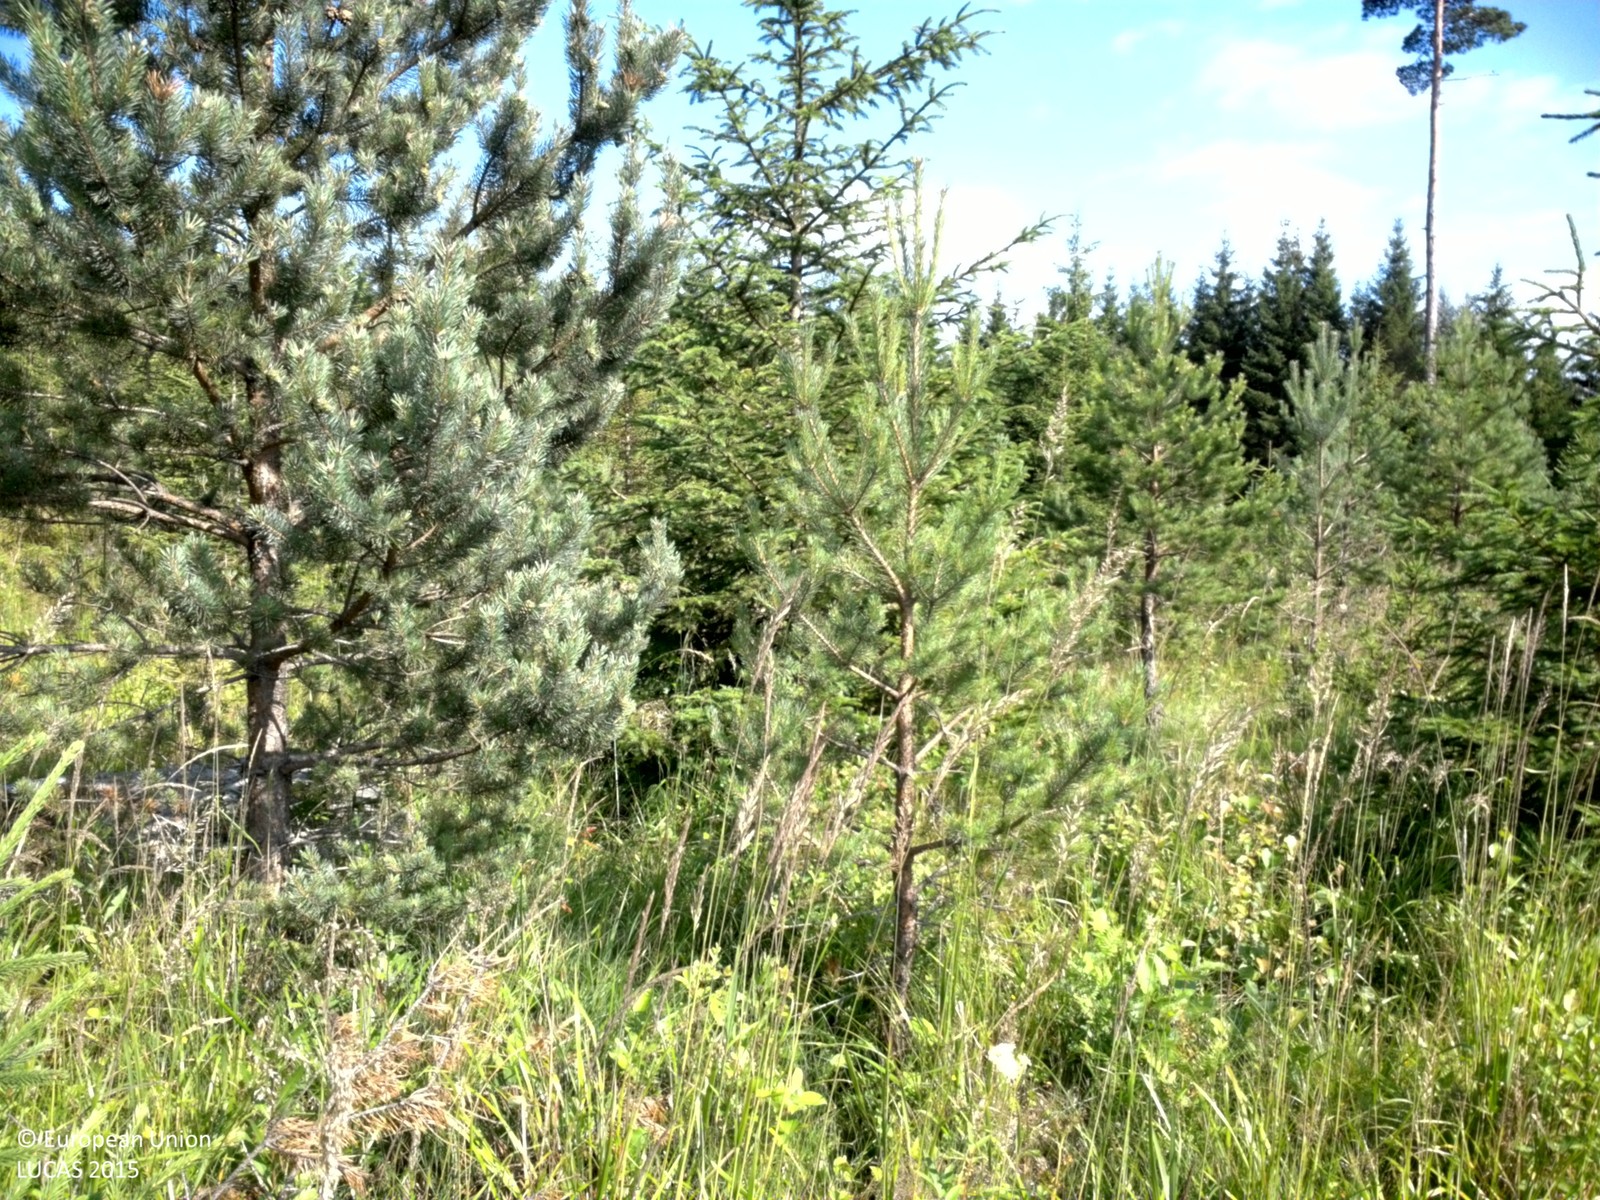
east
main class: Woodland
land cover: Spruce dominated coniferous woodland
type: boreal forest
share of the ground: 25 - 50 %
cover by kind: coniferous forest trees 50 %, herbaceous plants 50 %
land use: Forestry
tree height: < 5 m
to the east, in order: Spruce dominated coniferous woodland; Ditches and canals; Spruce dominated coniferous woodland; Ditches and canals; Spruce dominated coniferous woodland
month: July
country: SE
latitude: 59.6522
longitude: 18.4989
